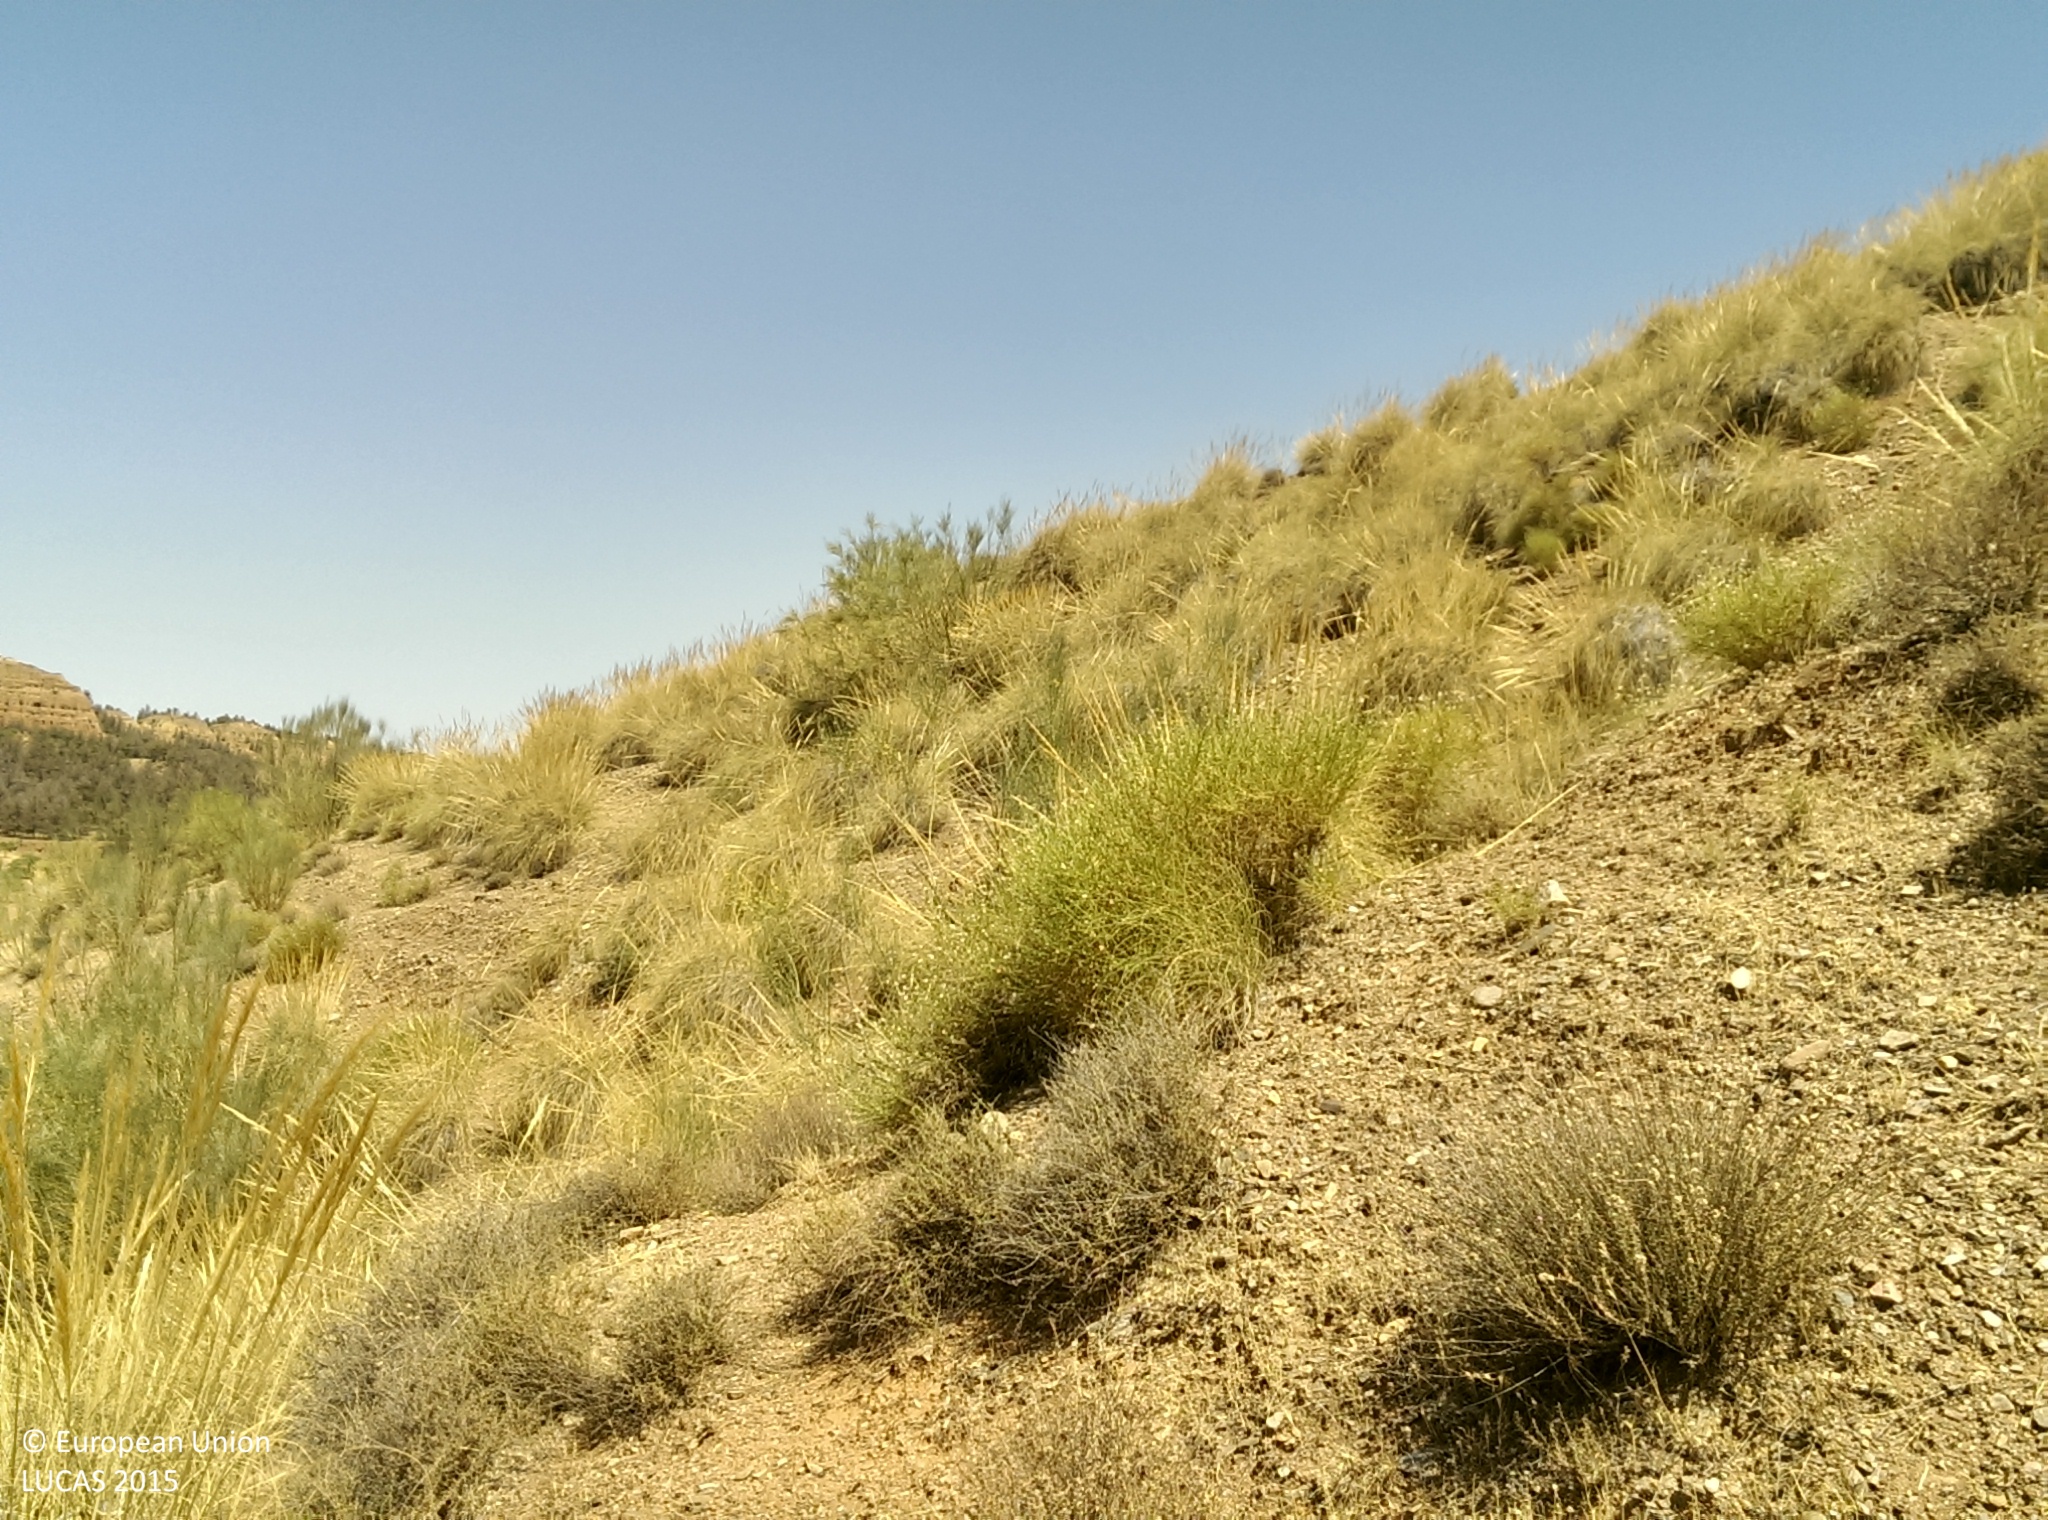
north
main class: Grassland
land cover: Grassland without tree/shrub cover
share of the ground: 50 - 75 %
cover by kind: herbaceous plants 70 %, unconsolidated bare surface 25 %, shrubs 5 %
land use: Semi-natural and natural areas not in use
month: July
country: ES
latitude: 37.2794
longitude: -3.2170
